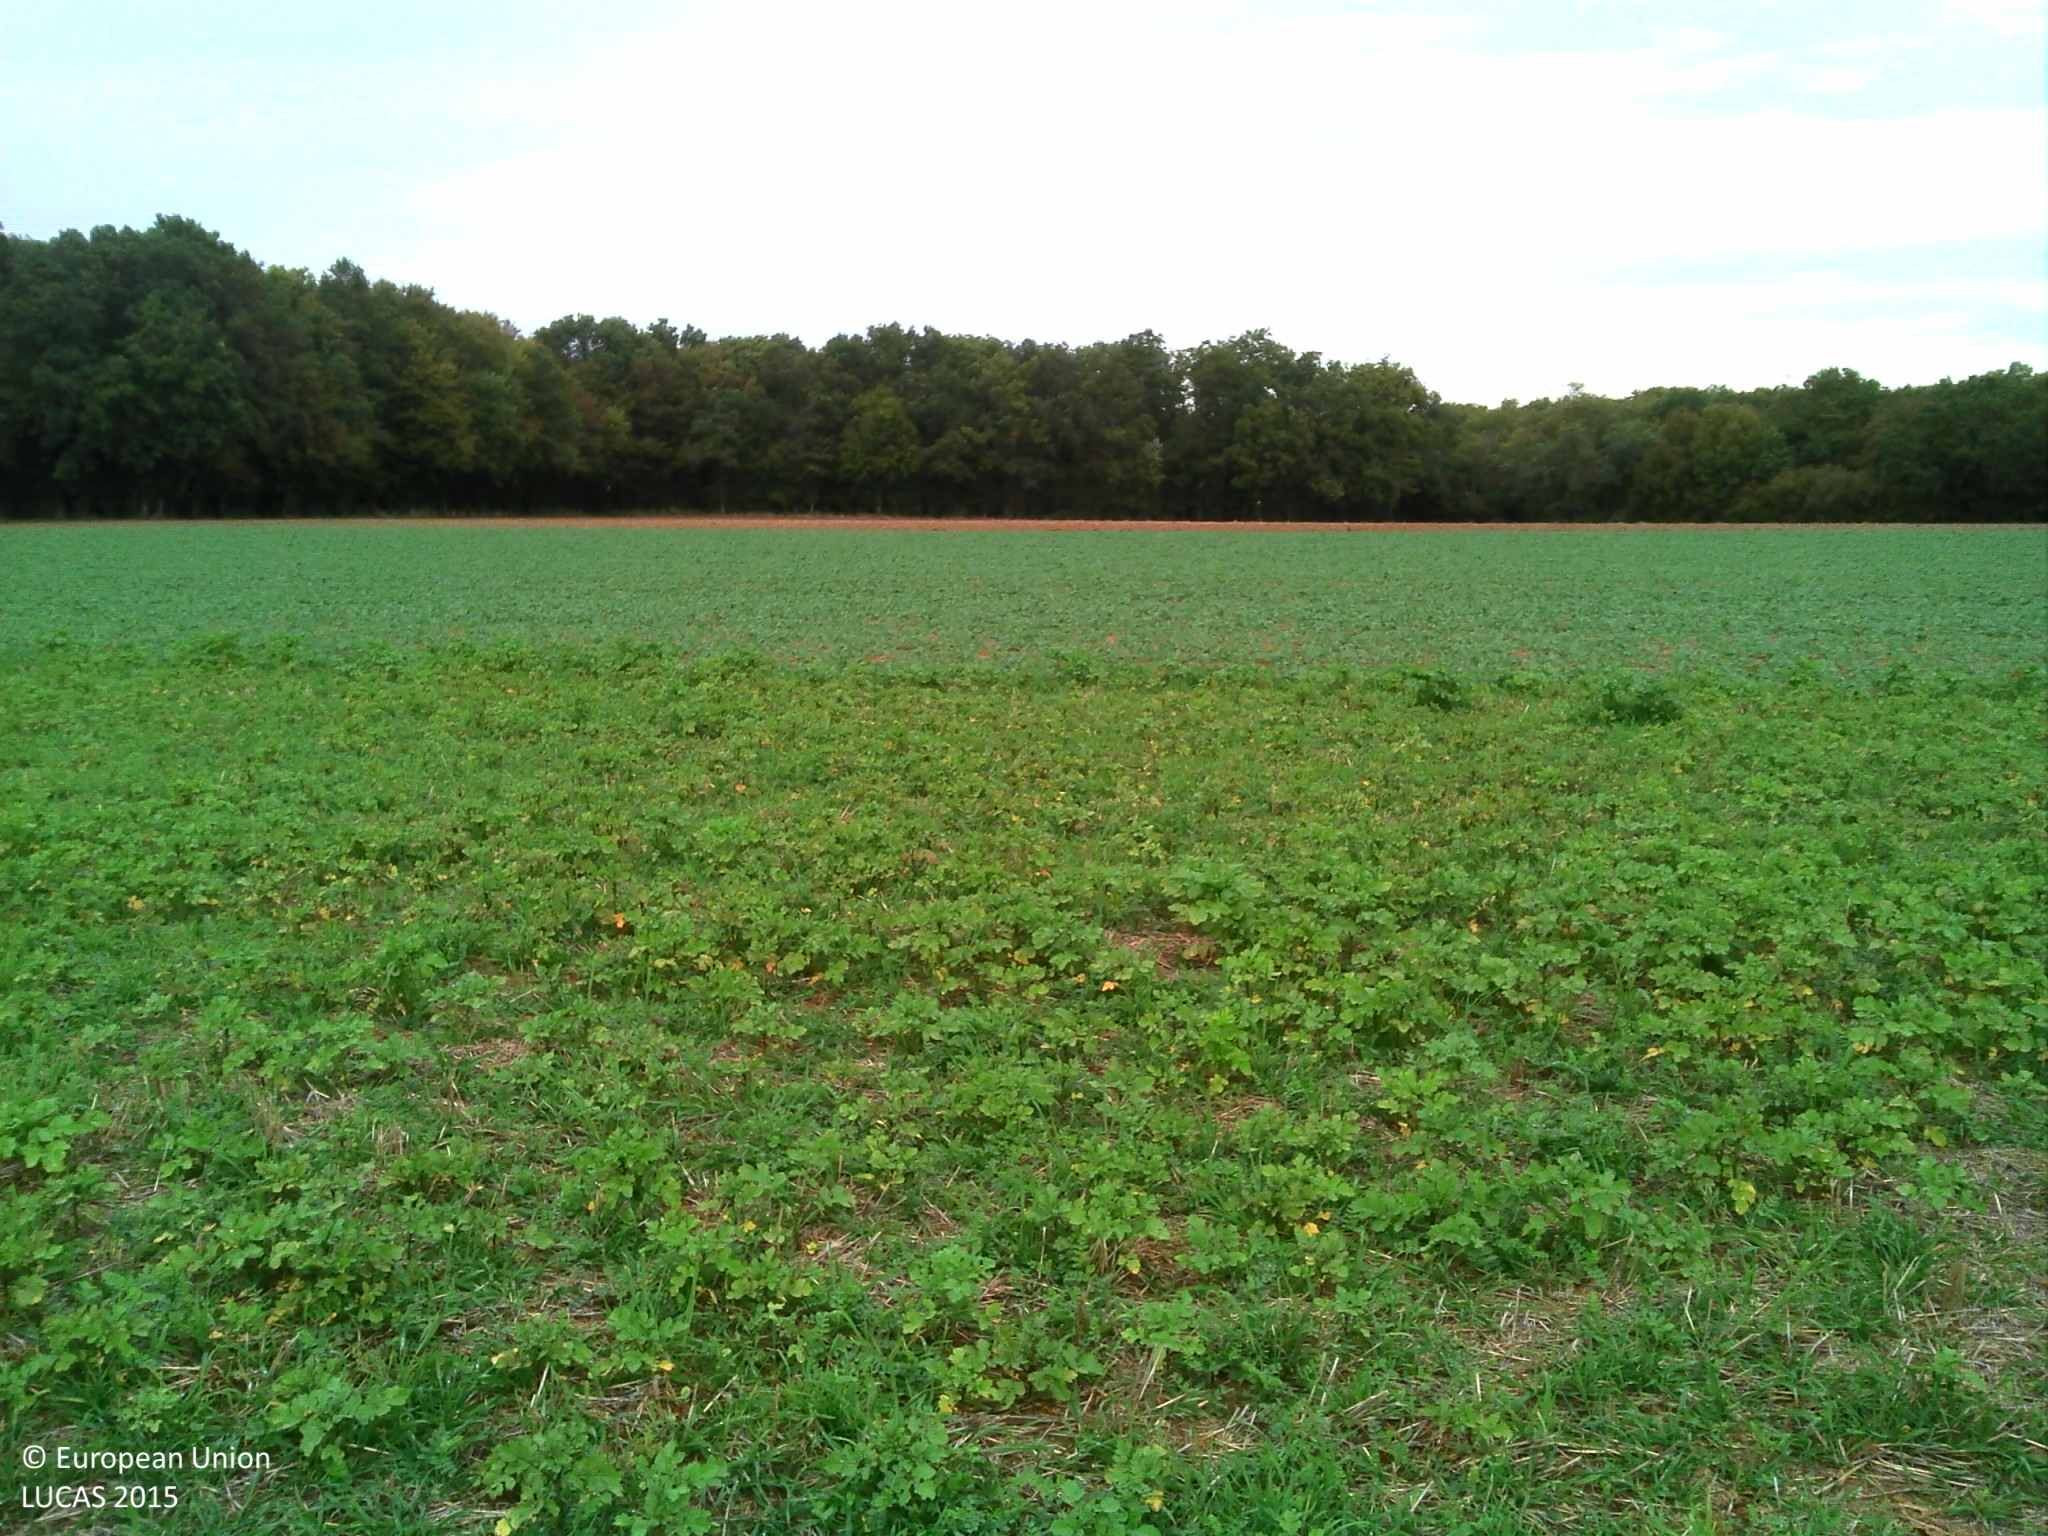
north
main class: Cropland
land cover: Other fibre and oleaginous crops
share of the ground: > 75 %
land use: Agriculture (excluding fallow land and kitchen gardens)
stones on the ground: < 10 %
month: October
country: FR
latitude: 48.0951
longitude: 4.3177
